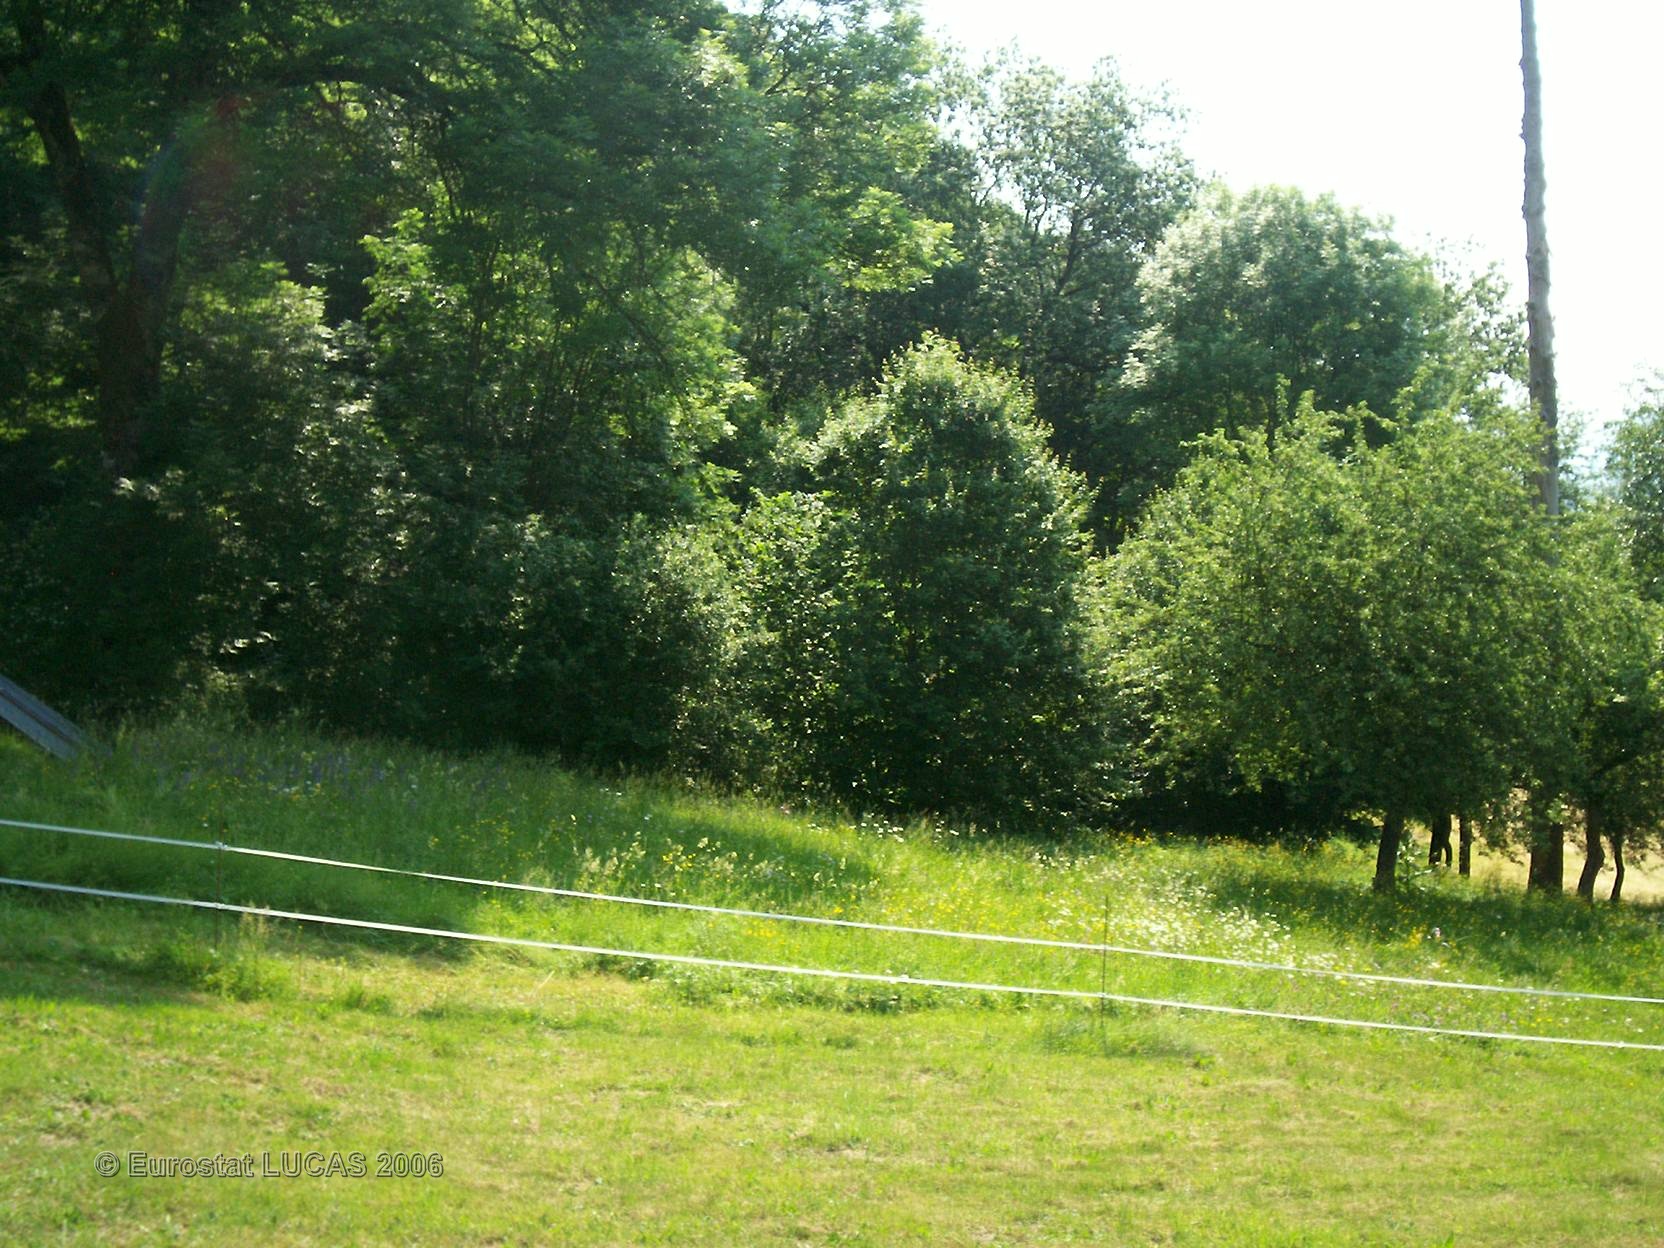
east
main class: Grassland
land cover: Grassland with sparse tree/shrub cover
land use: Agriculture (excluding fallow land and kitchen gardens)
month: June
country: FR
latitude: 46.1006
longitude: 6.6532
